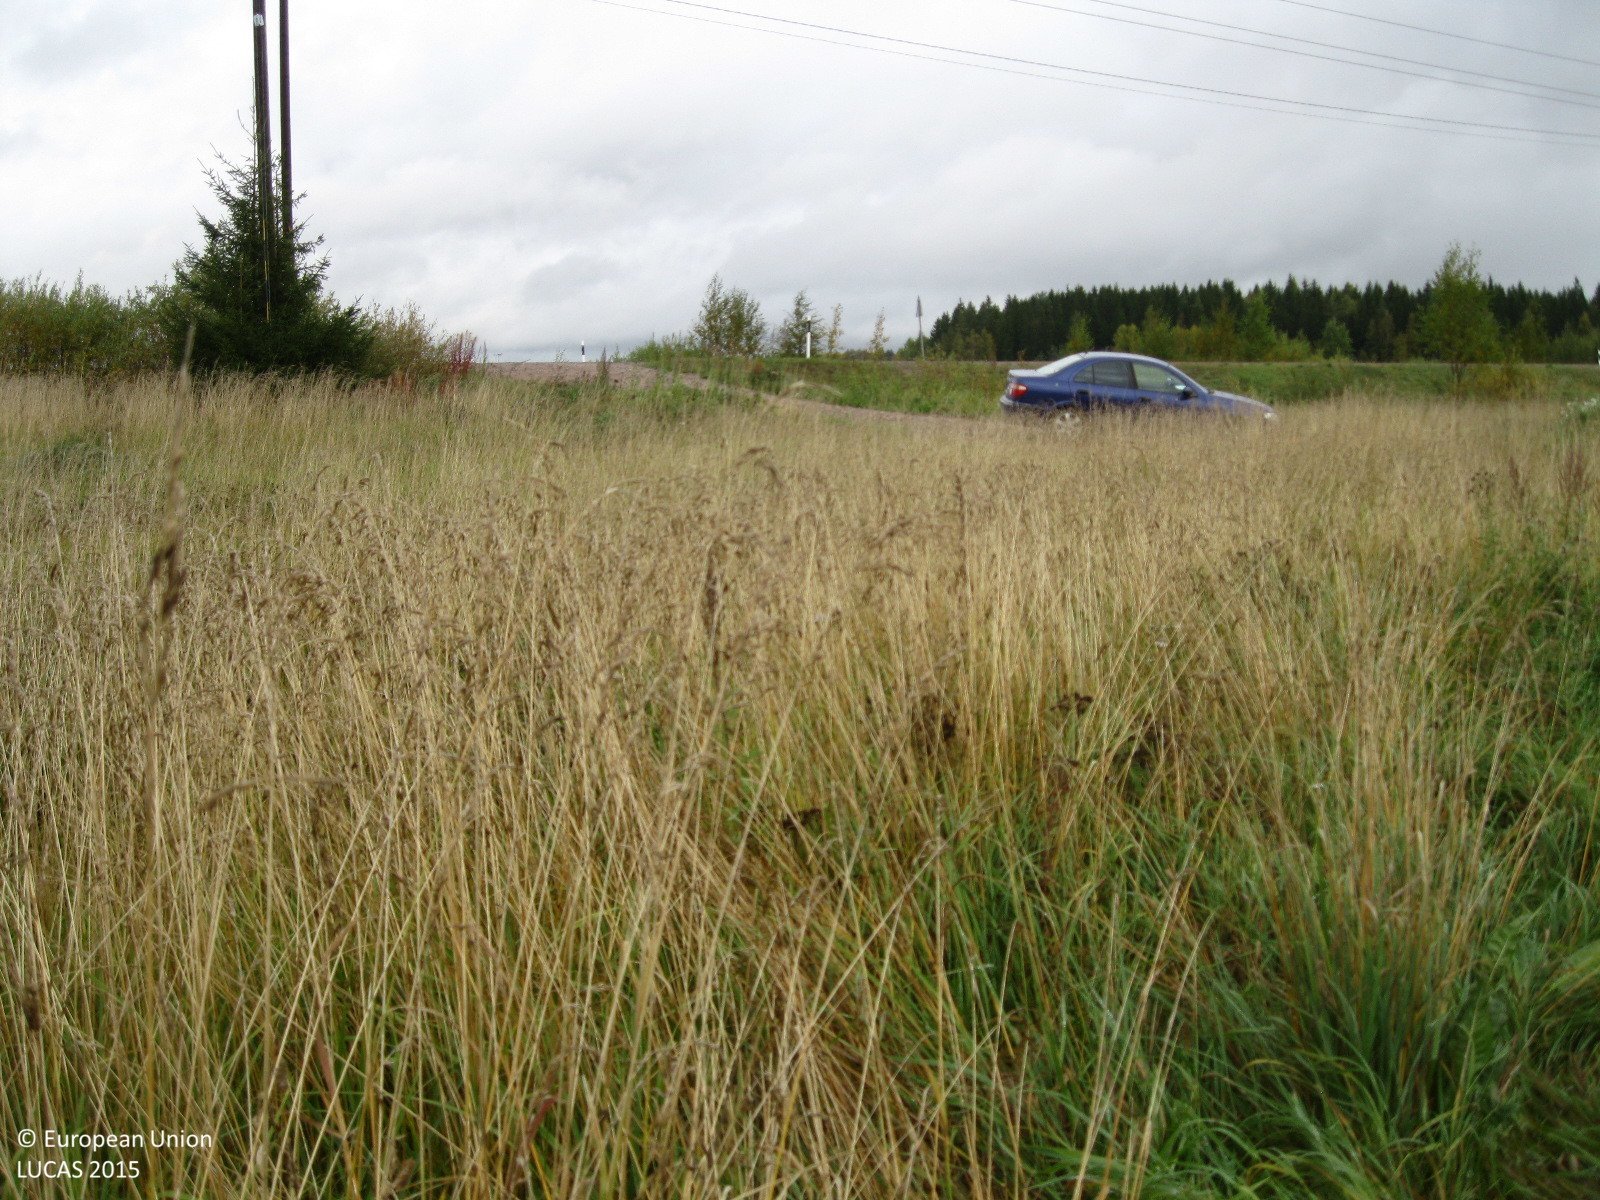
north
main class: Grassland
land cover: Spontaneously vegetated surfaces
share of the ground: > 75 %
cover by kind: herbaceous plants 100 %
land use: Sport
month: September
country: FI
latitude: 60.7698
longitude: 24.8161
